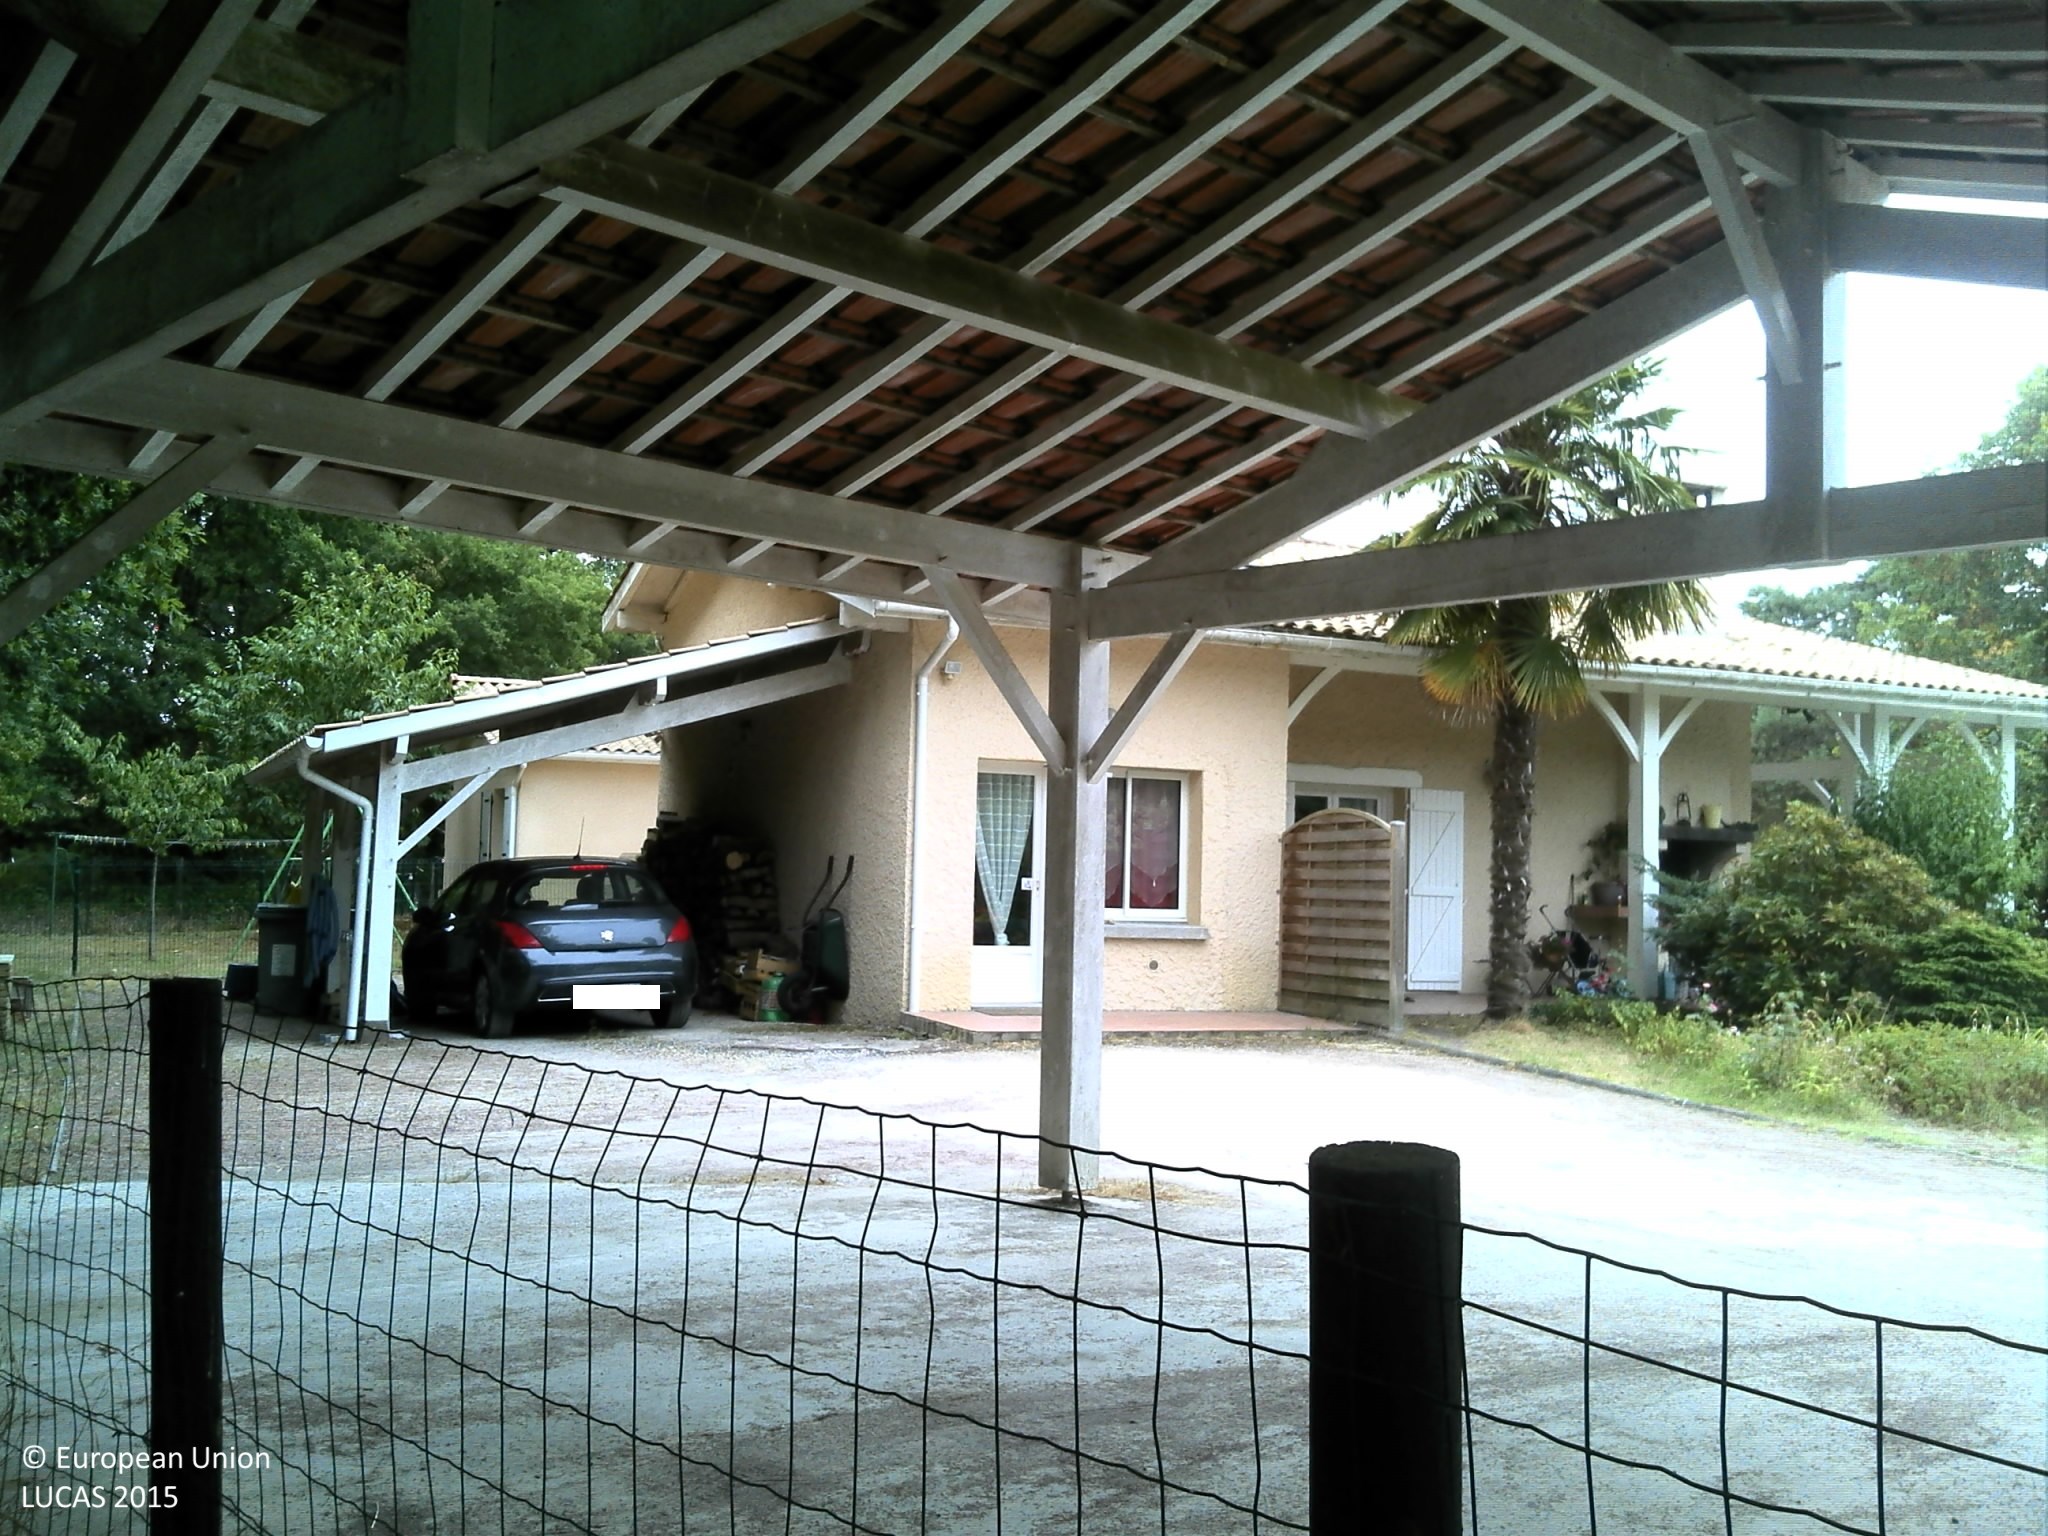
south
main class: Woodland
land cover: Broadleaved woodland
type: mesophytic deciduous forest
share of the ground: > 75 %
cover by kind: broadleaved forest trees 80 %, shrubs 10 %, herbaceous plants 5 %, lichens and mosses 5 %
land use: Semi-natural and natural areas not in use
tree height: > 5 m
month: July
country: FR
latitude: 44.6427
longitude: -0.5954
